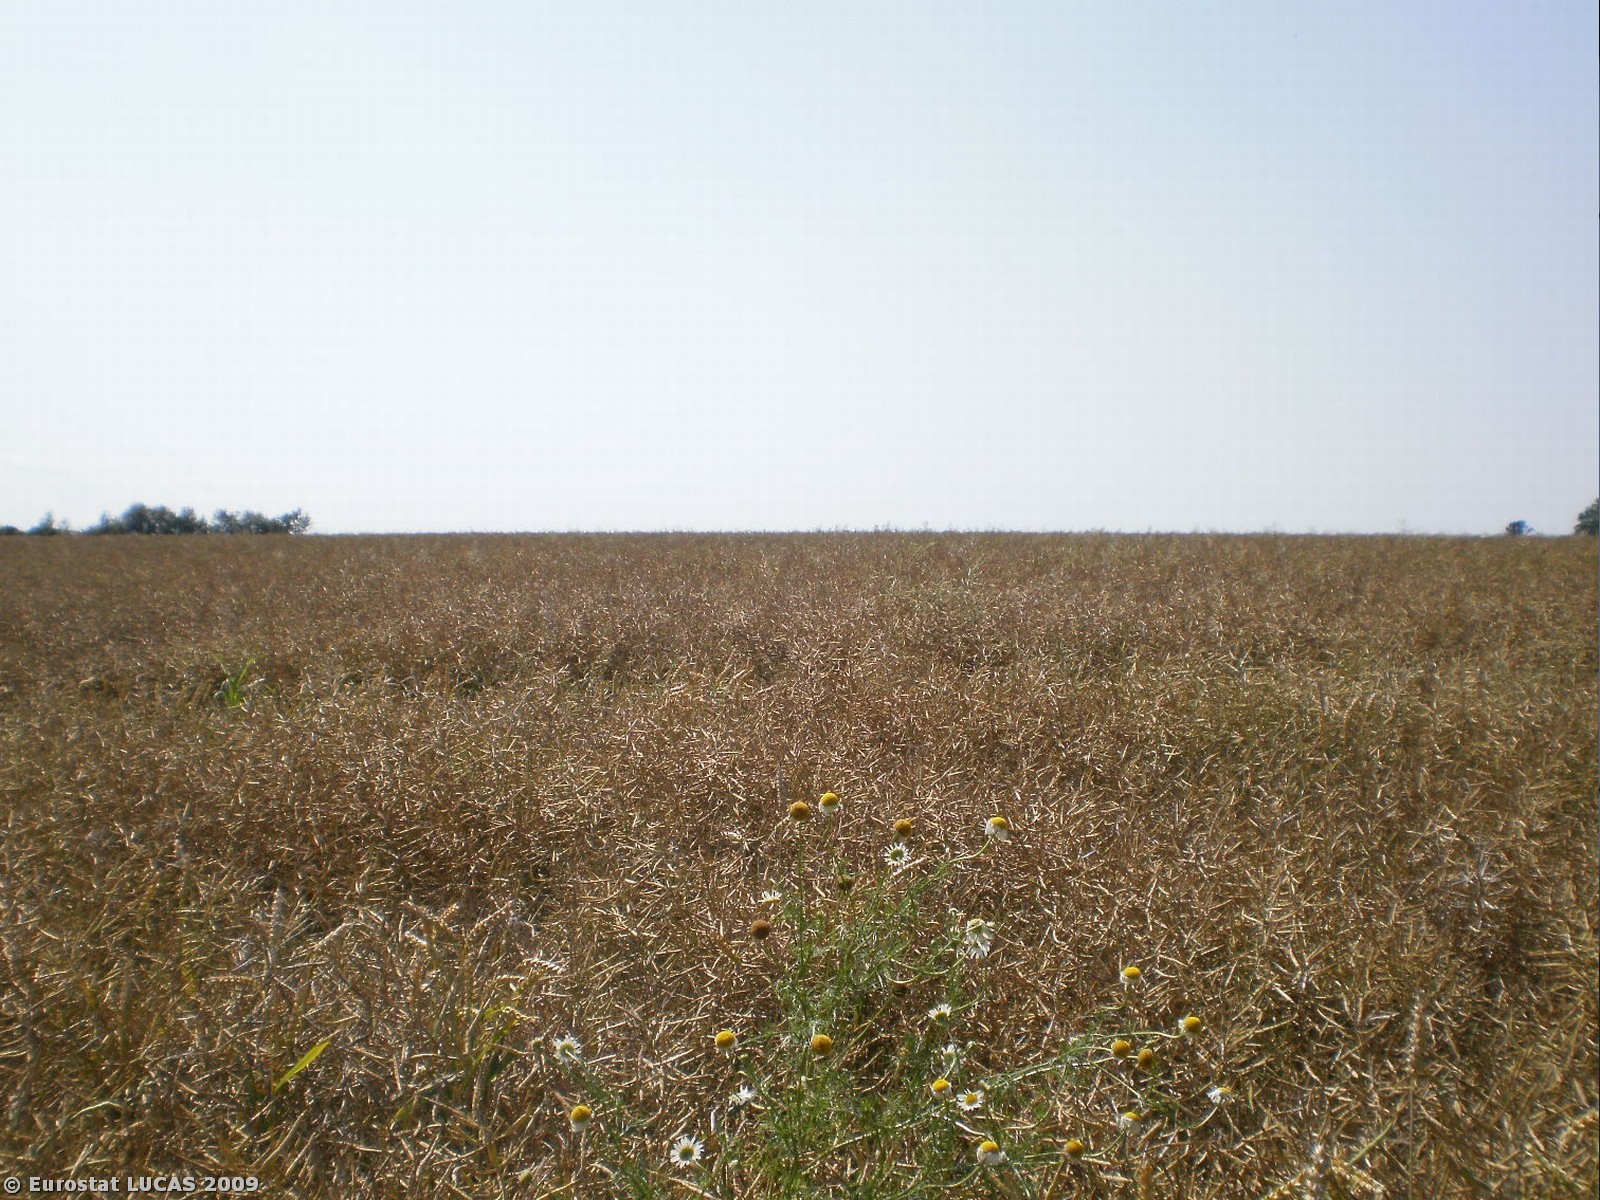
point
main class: Cropland
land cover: Rape and turnip rape
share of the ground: > 75 %
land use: Agriculture (excluding fallow land and kitchen gardens)
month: July
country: PL
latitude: 54.2296
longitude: 19.6454
